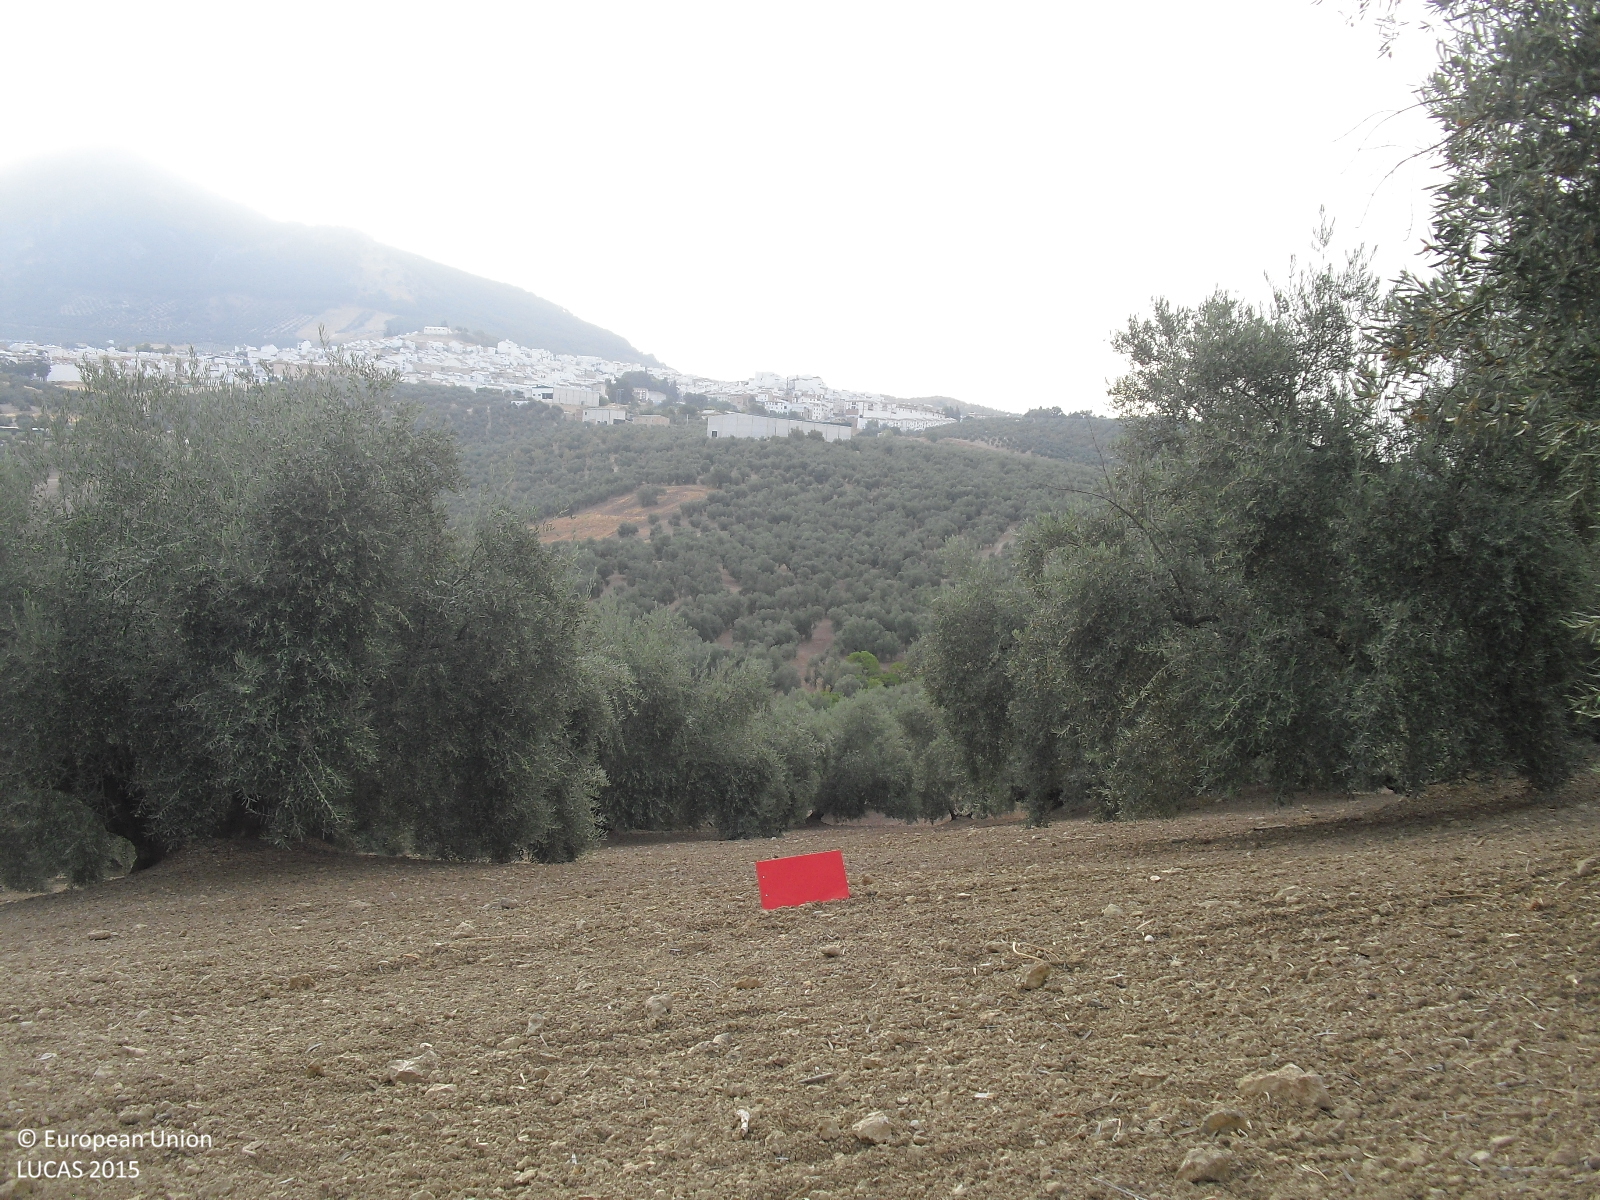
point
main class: Cropland
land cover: Olive groves
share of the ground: 25 - 50 %
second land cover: Other bare soil
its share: > 75 %
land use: Agriculture (excluding fallow land and kitchen gardens)
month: August
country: ES
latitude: 37.3273
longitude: -4.3892
